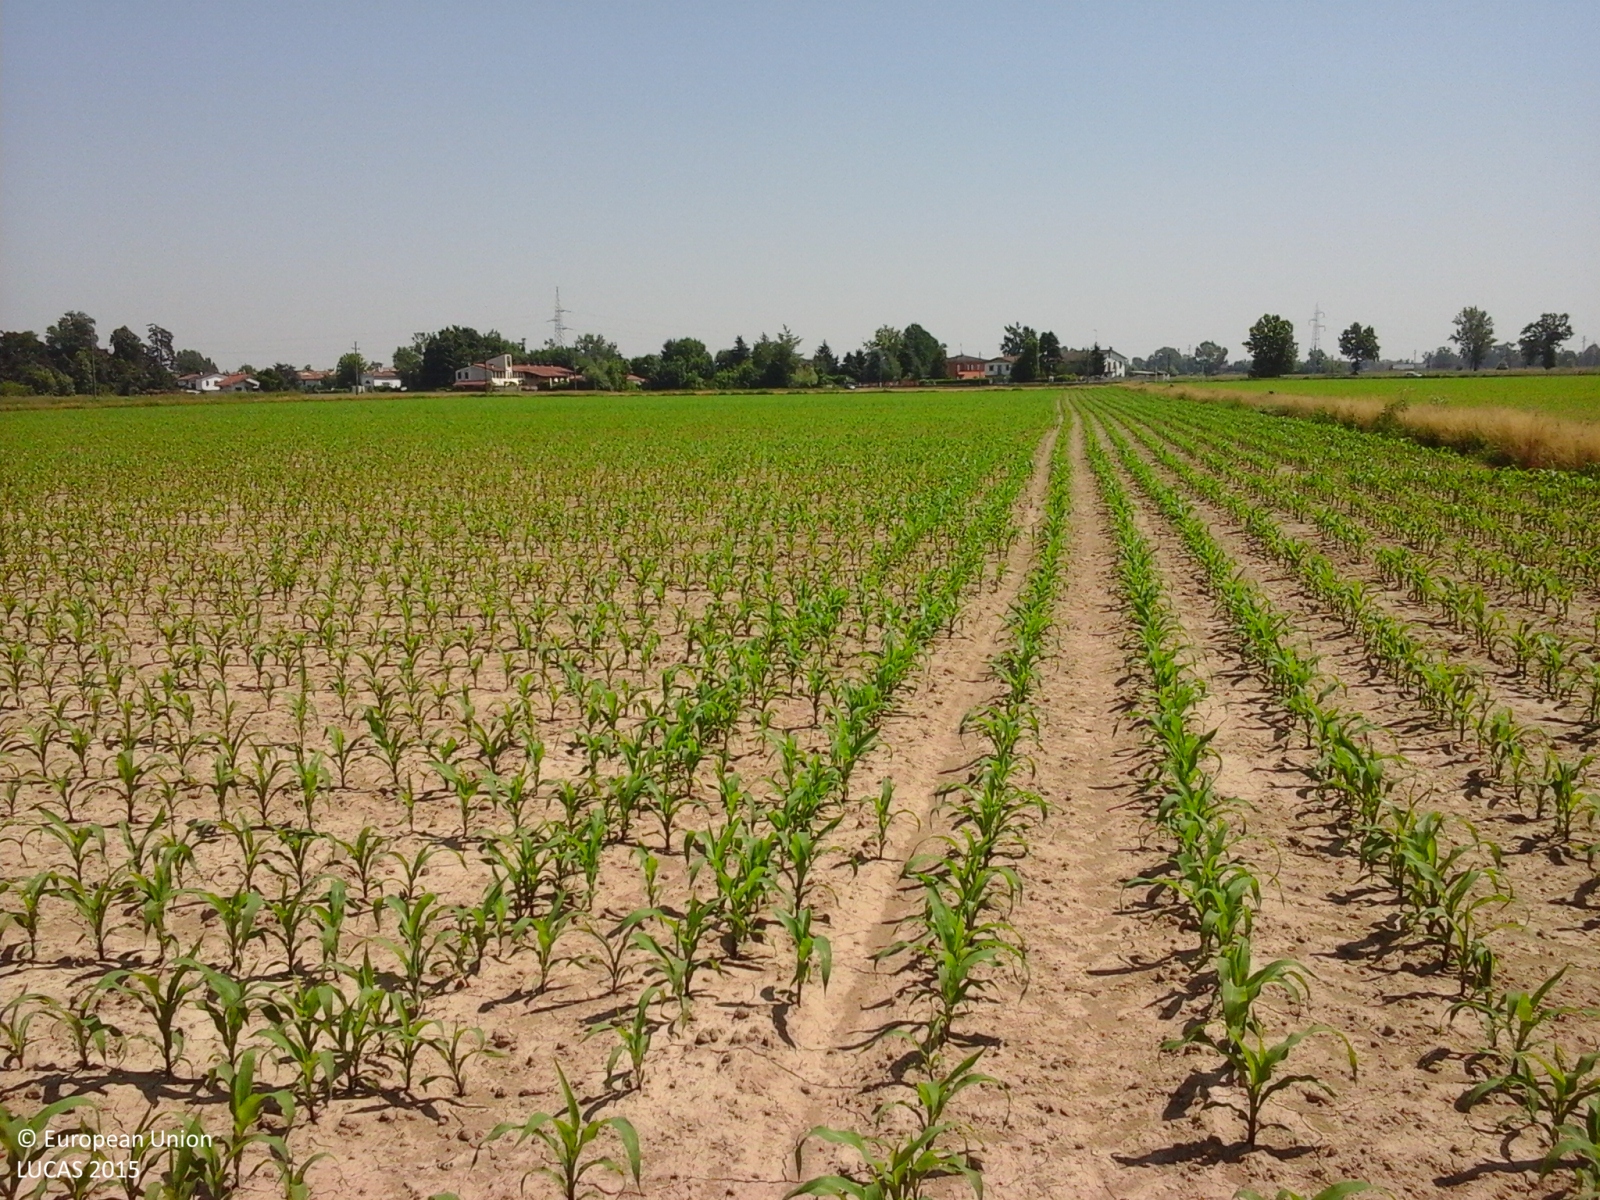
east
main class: Cropland
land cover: Maize
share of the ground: 25 - 50 %
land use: Agriculture (excluding fallow land and kitchen gardens)
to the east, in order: Maize; Grass margins; Ditches and canals; Grass margins; Soya
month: May
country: IT
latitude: 45.1619
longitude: 10.0635
